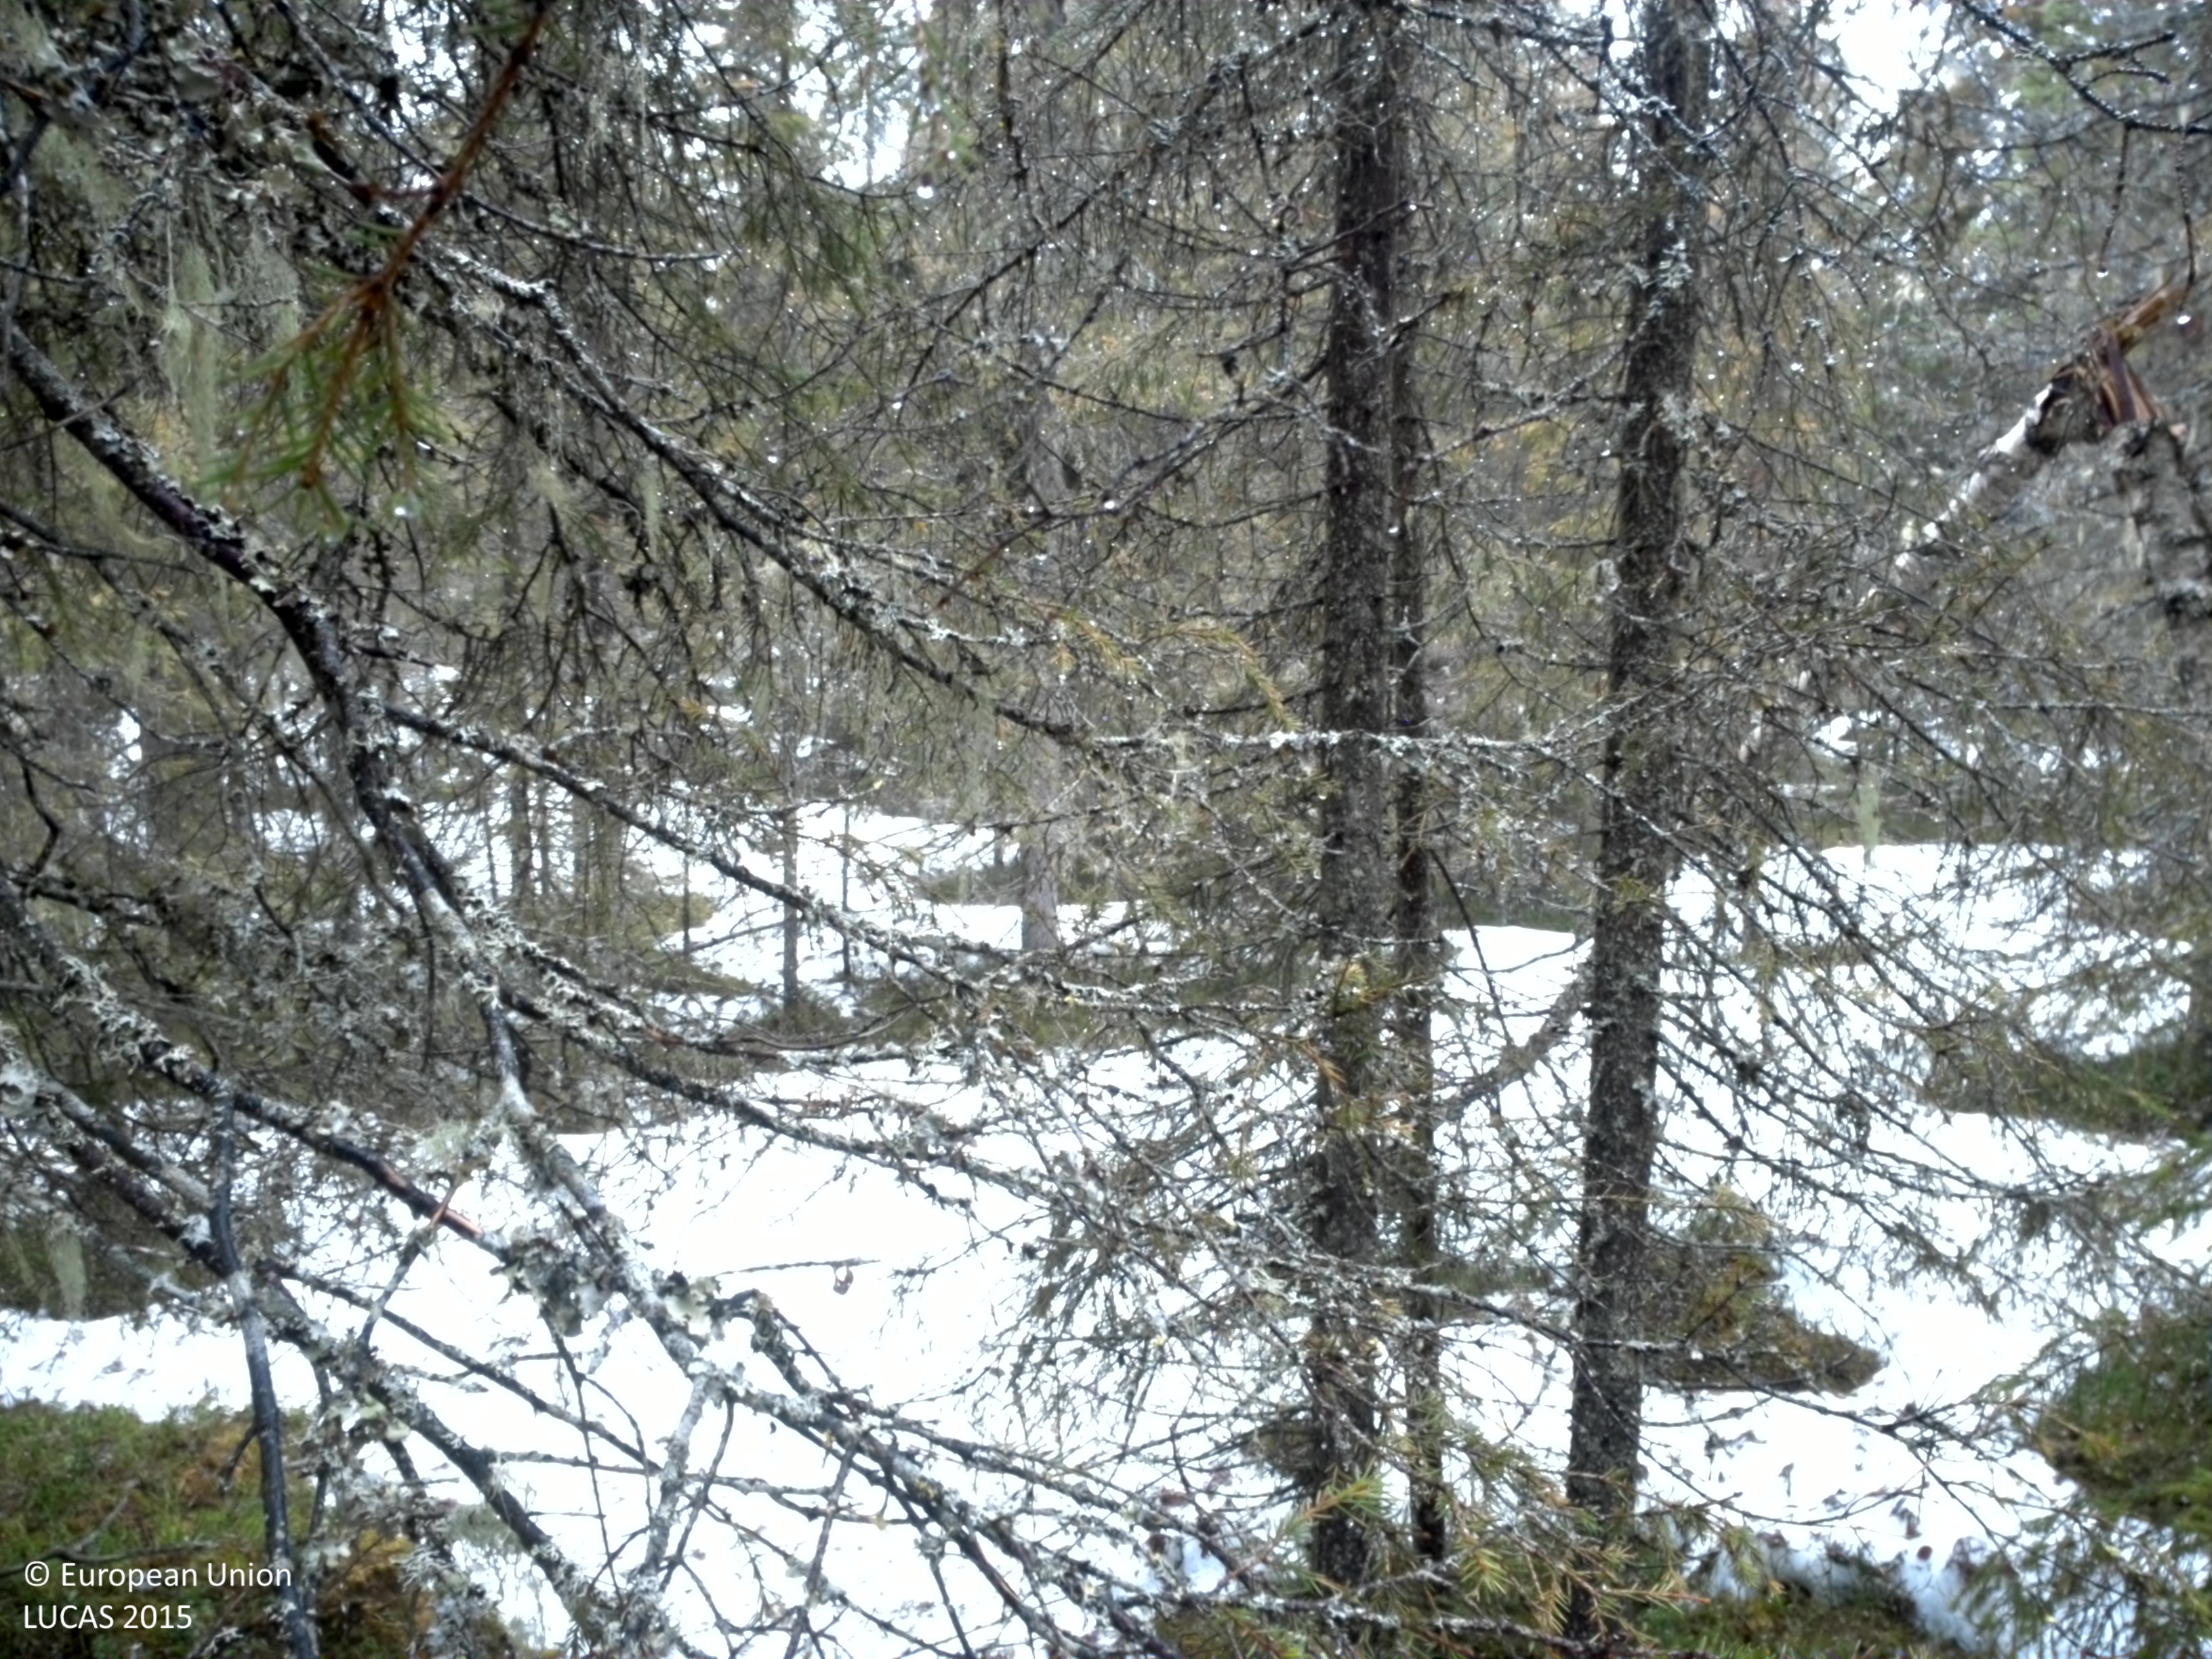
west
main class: Woodland
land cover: Spruce dominated coniferous woodland
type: boreal forest
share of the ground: > 75 %
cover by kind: coniferous forest trees 75 %, shrubs 15 %, lichens and mosses 10 %
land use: Forestry
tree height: > 5 m
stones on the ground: > 50 %
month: May
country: SE
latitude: 66.5301
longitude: 23.4156
